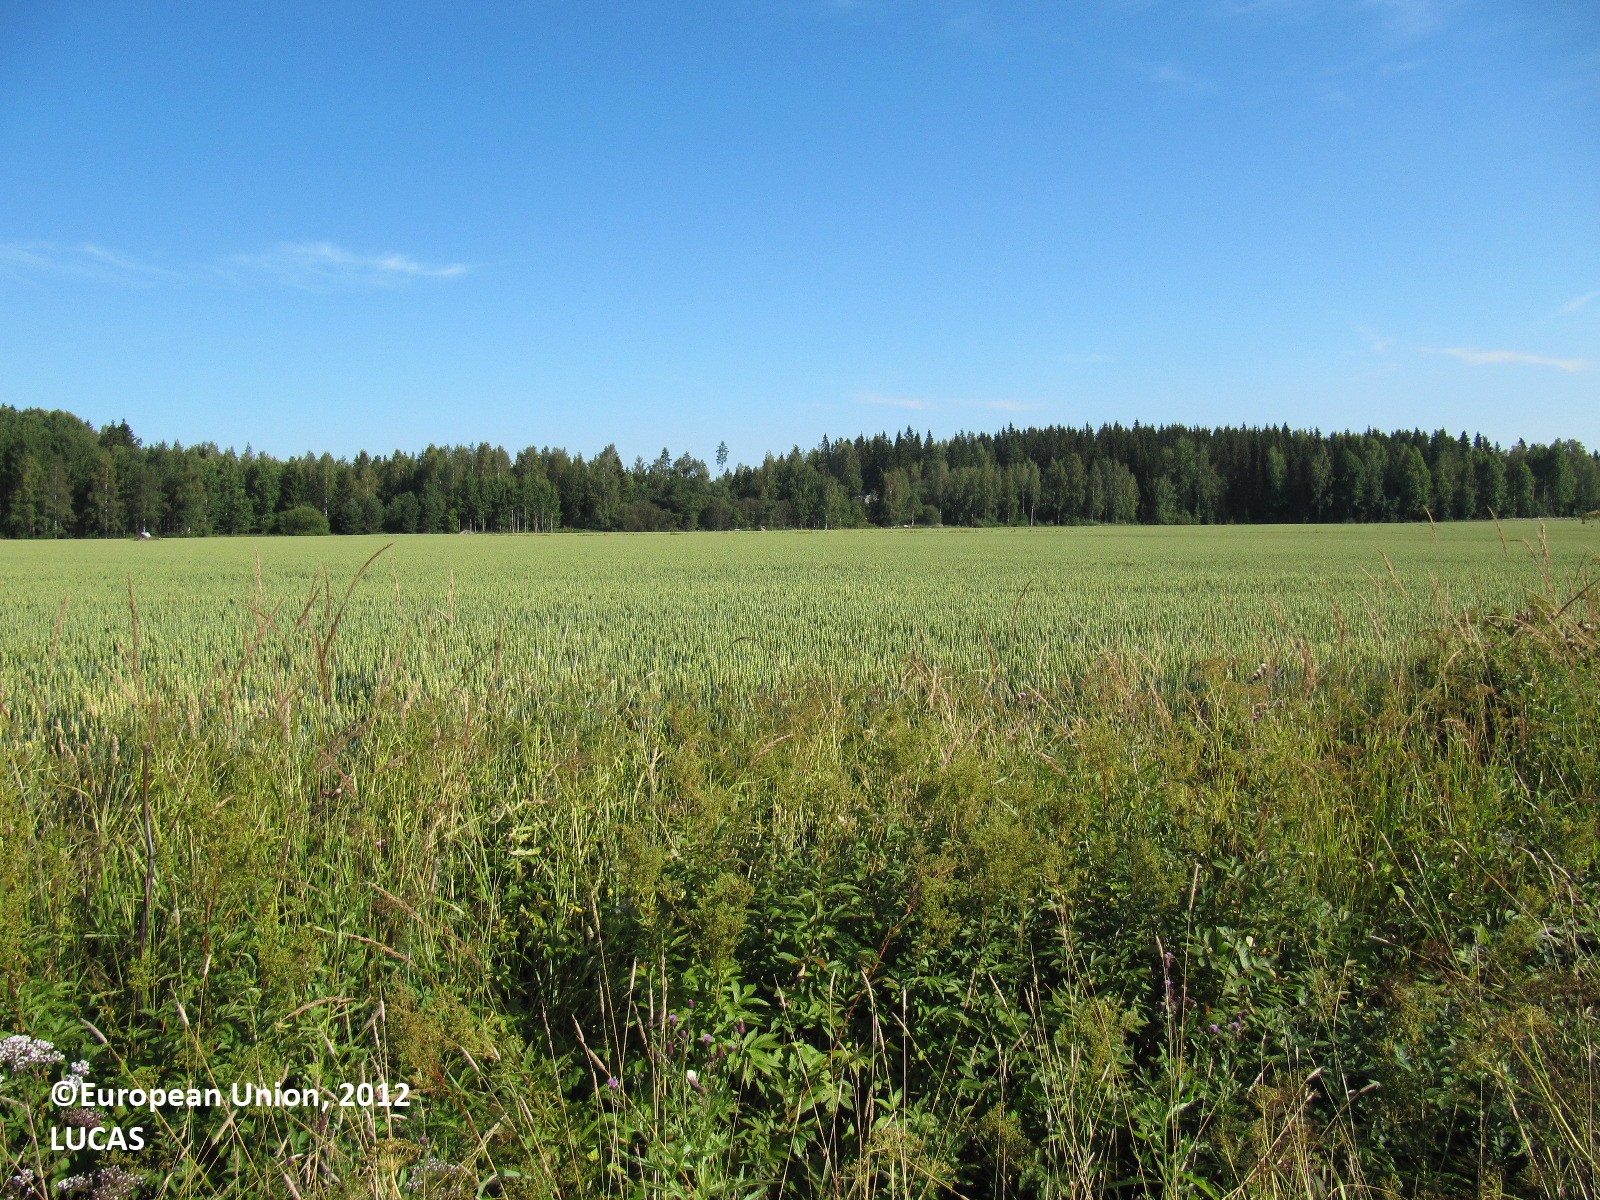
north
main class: Grassland
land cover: Grassland without tree/shrub cover
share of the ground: > 75 %
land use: Agriculture (excluding fallow land and kitchen gardens)
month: August
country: FI
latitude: 60.7080
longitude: 24.5255
